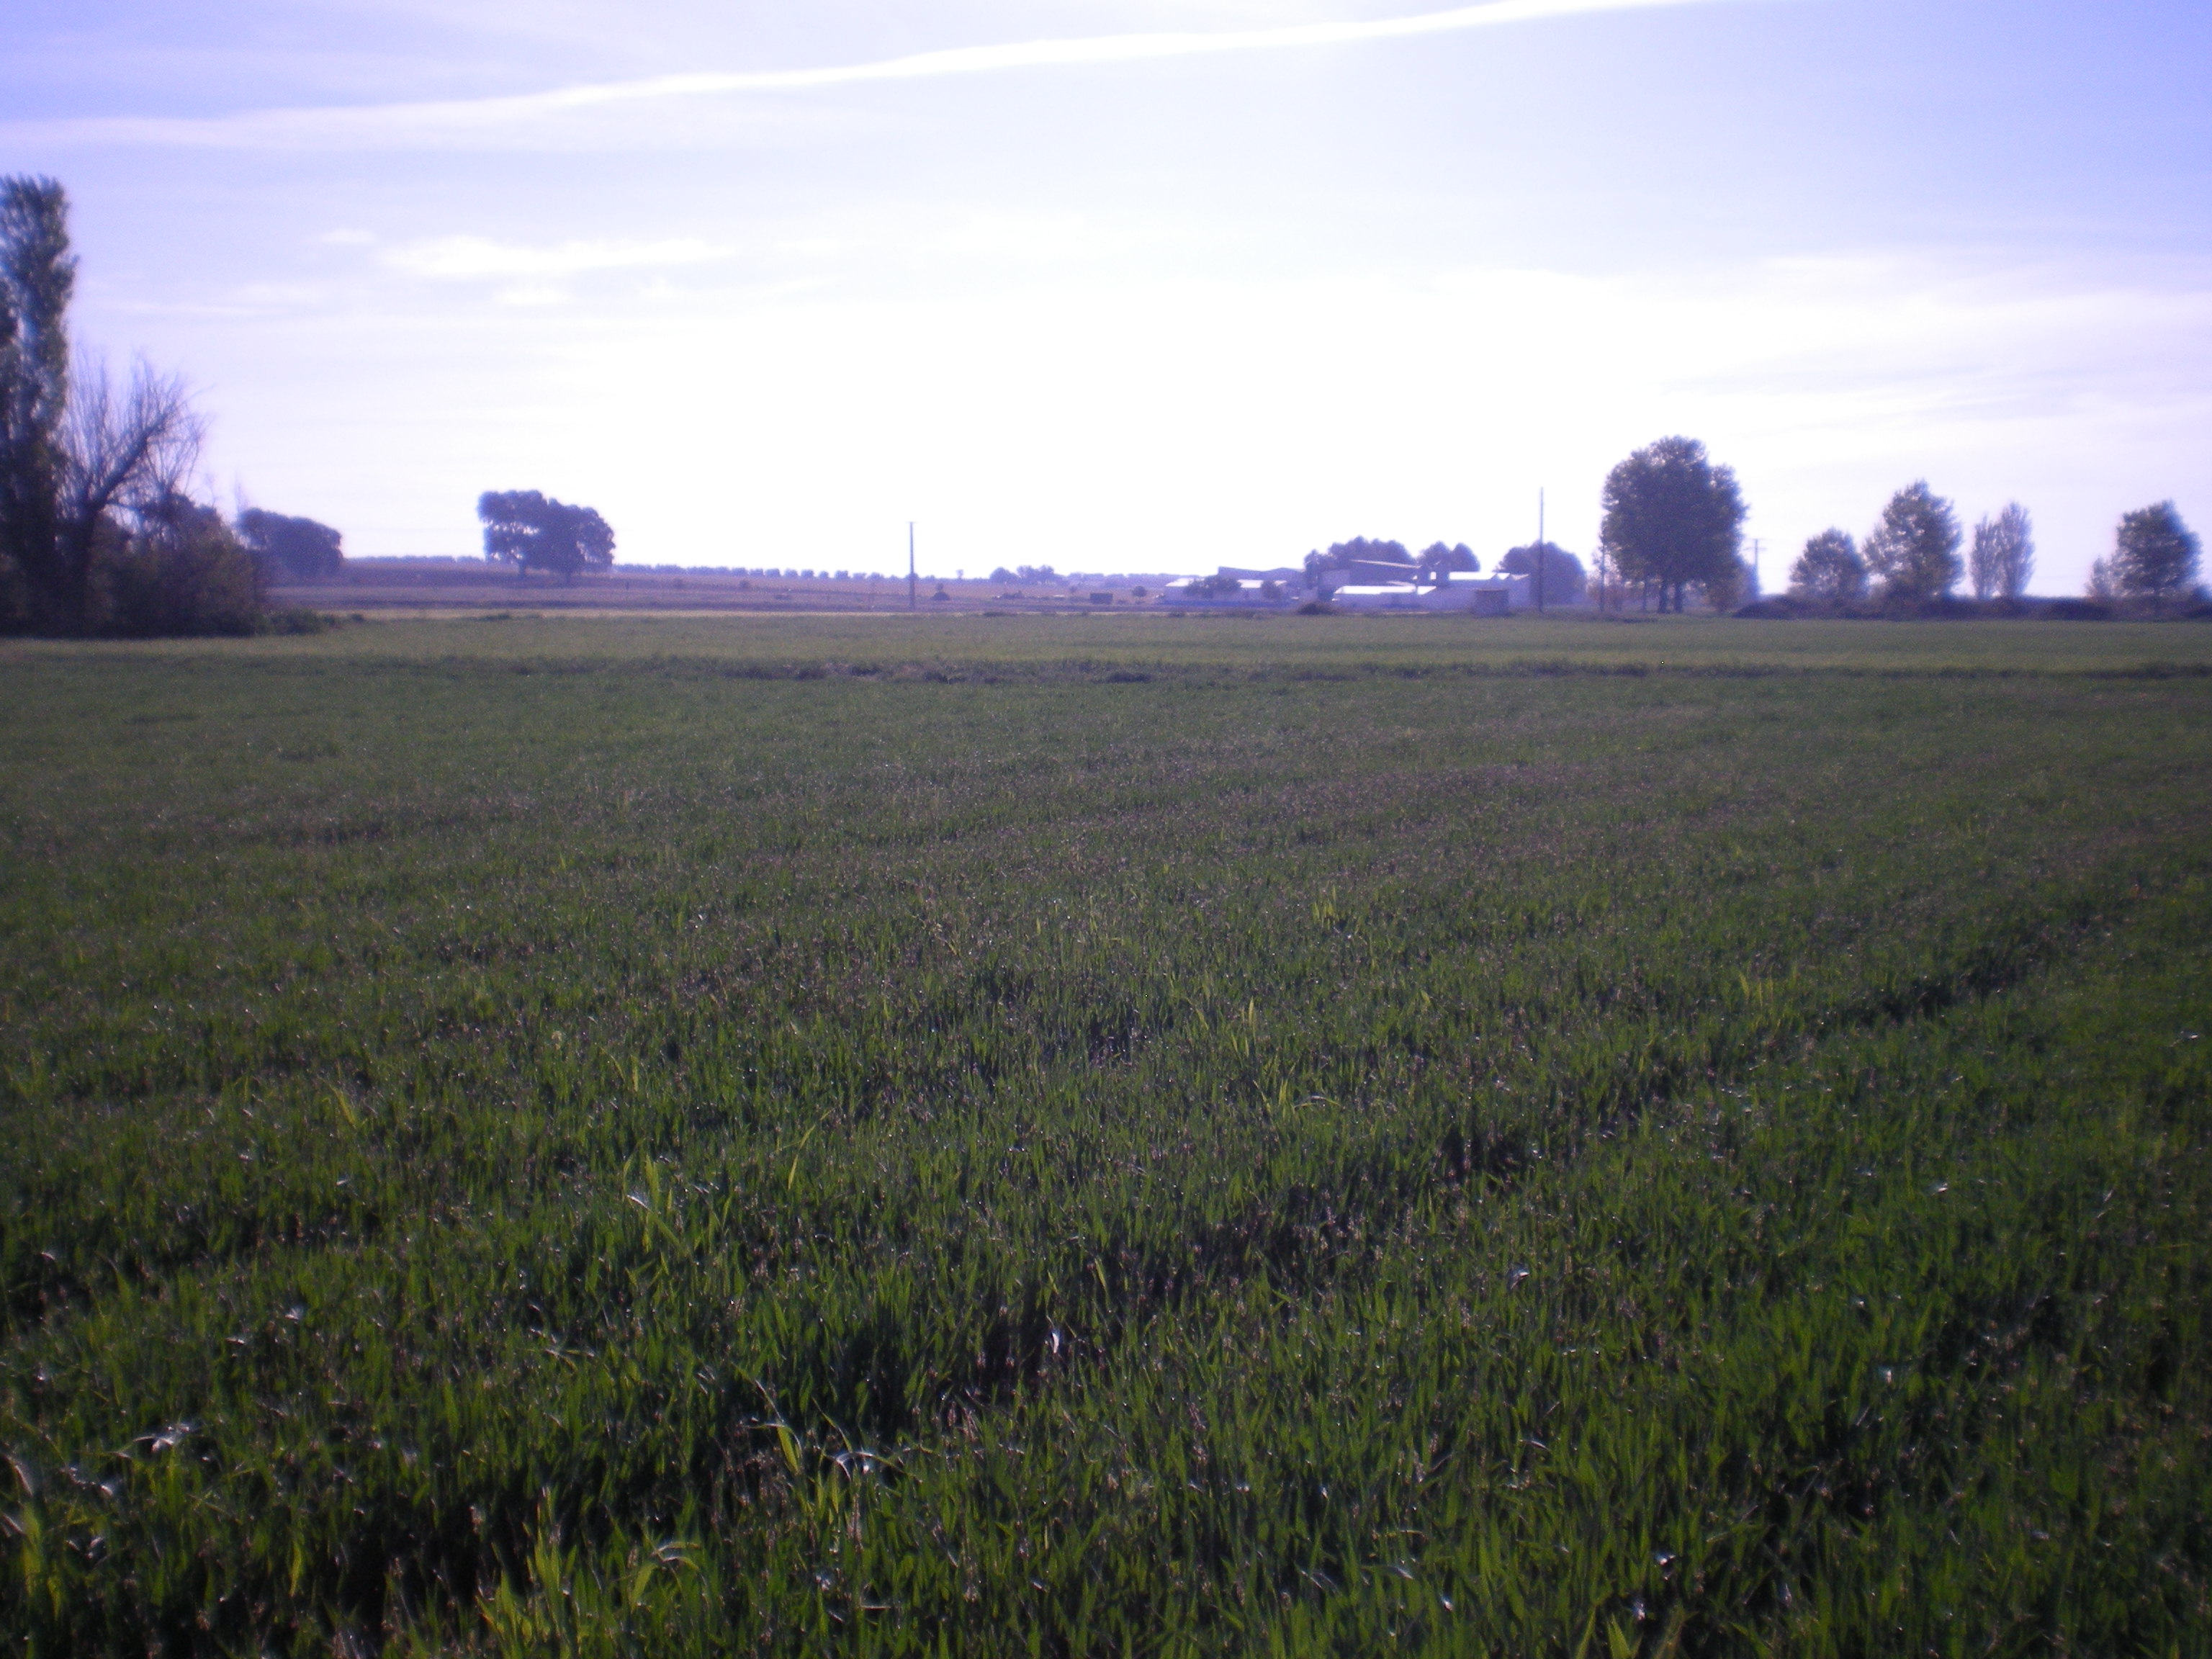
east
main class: Cropland
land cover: Durum wheat
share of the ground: > 75 %
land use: Agriculture (excluding fallow land and kitchen gardens)
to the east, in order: Durum wheat; Grass margins; Tracks; Grass margins; Durum wheat; Grass margins; Rivers and streams; Grass margins; Barley
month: April
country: ES
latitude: 38.7801
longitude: -3.2360
